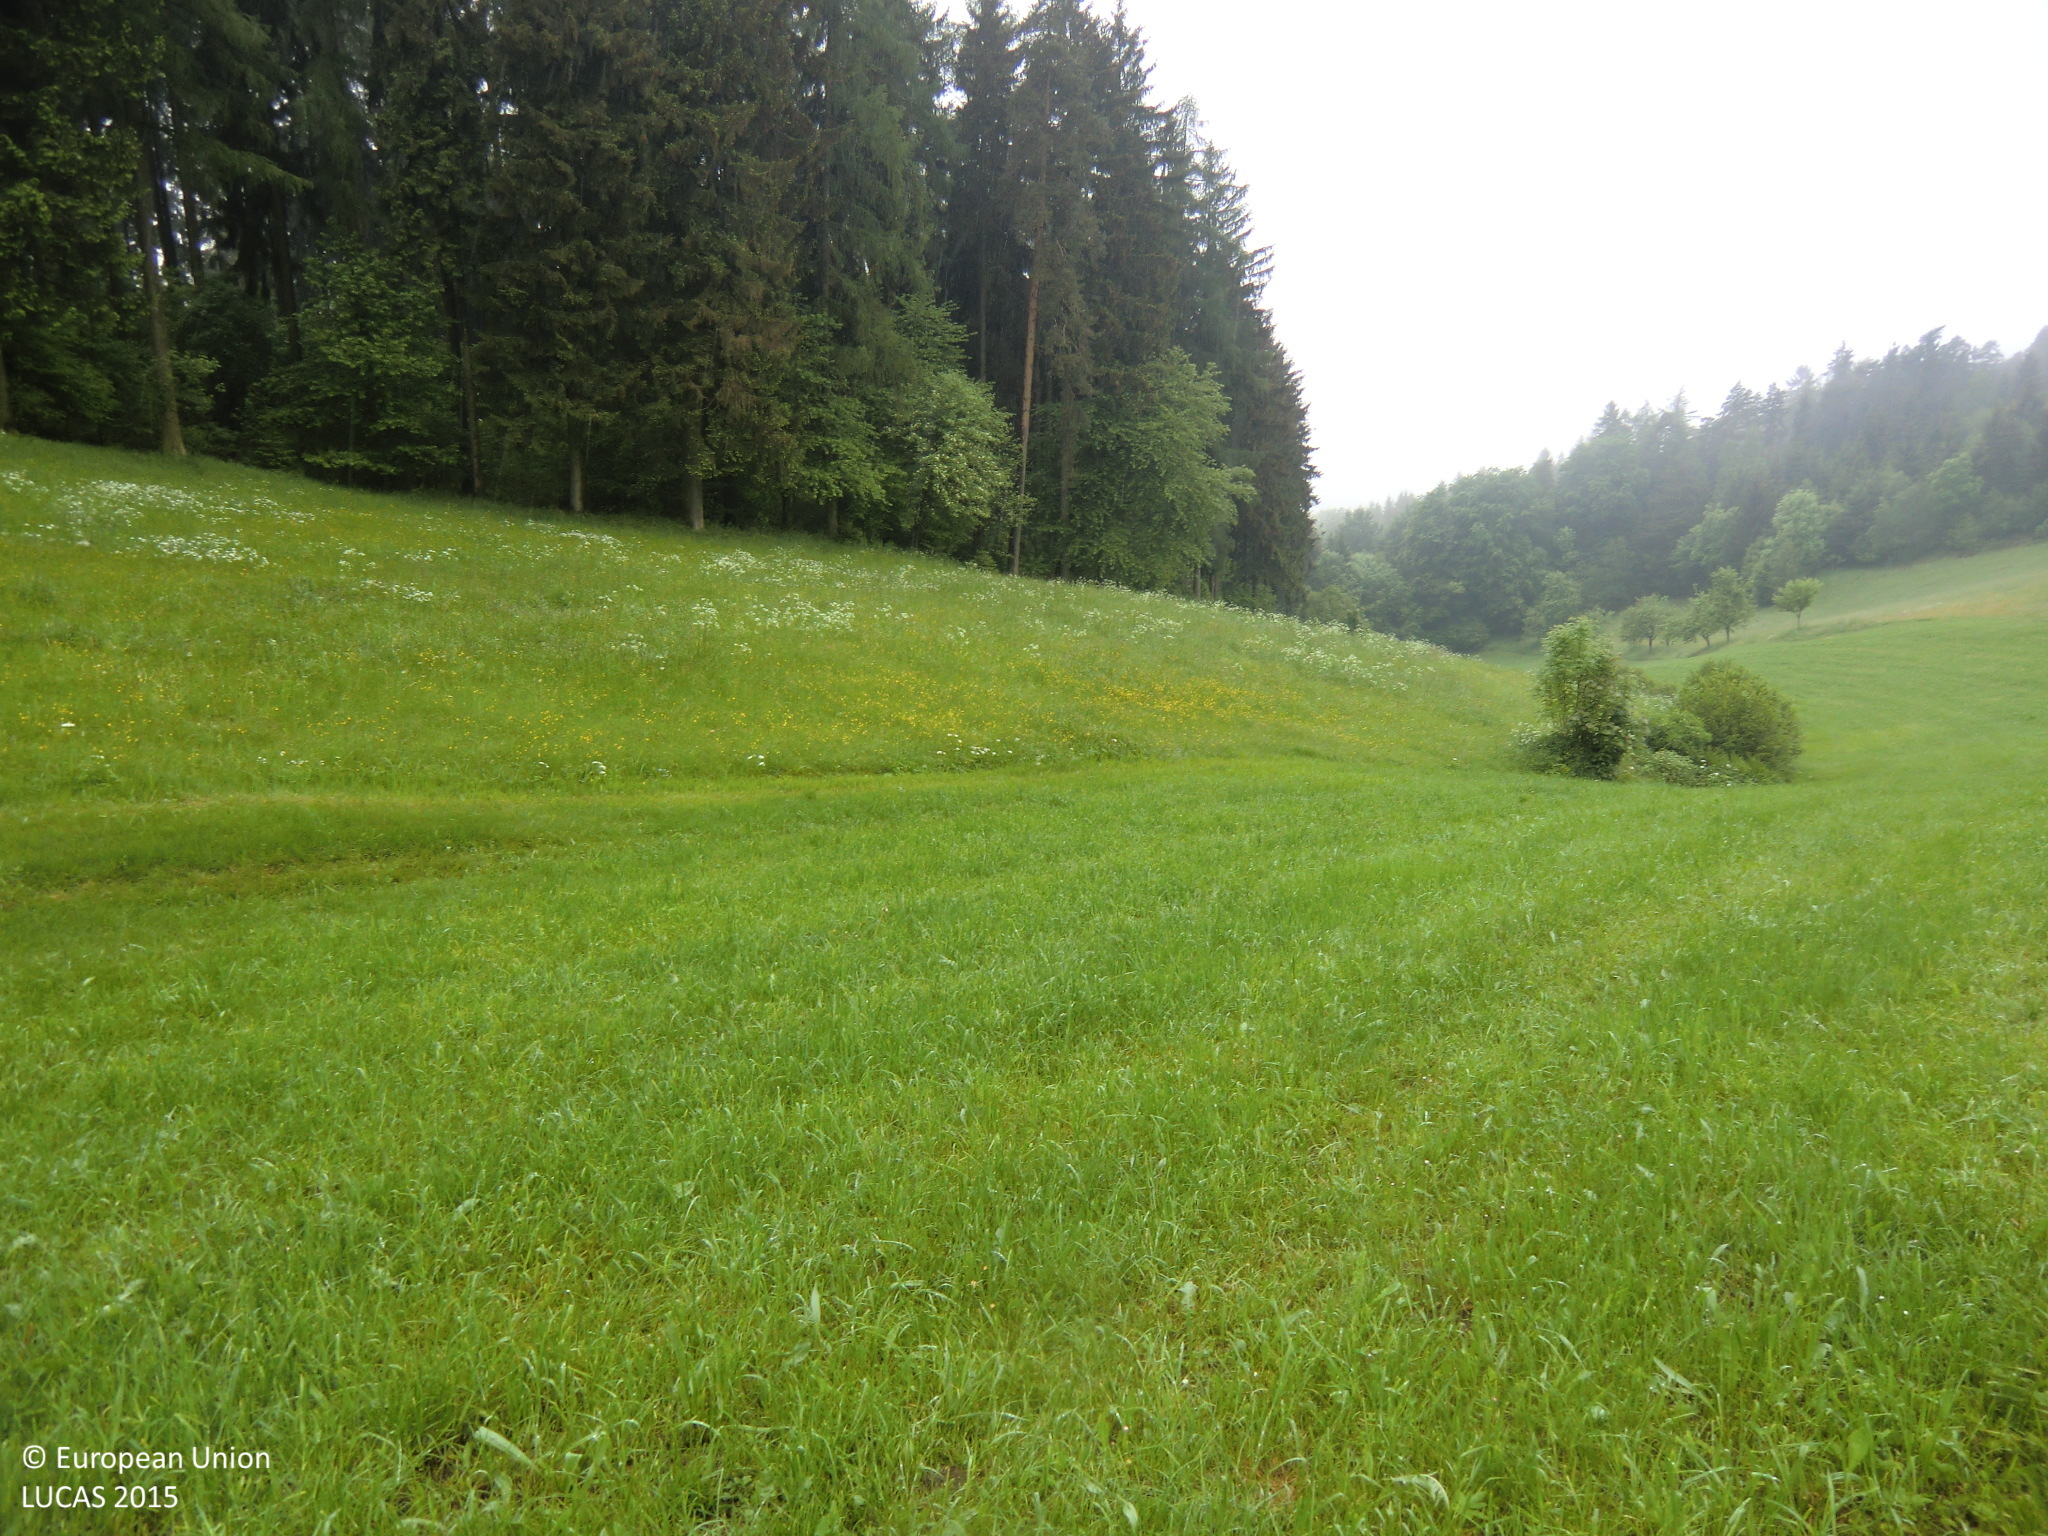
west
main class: Grassland
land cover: Grassland without tree/shrub cover
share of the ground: > 75 %
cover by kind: herbaceous plants 100 %
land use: Agriculture (excluding fallow land and kitchen gardens)
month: May
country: AT
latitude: 48.3988
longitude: 14.5795
